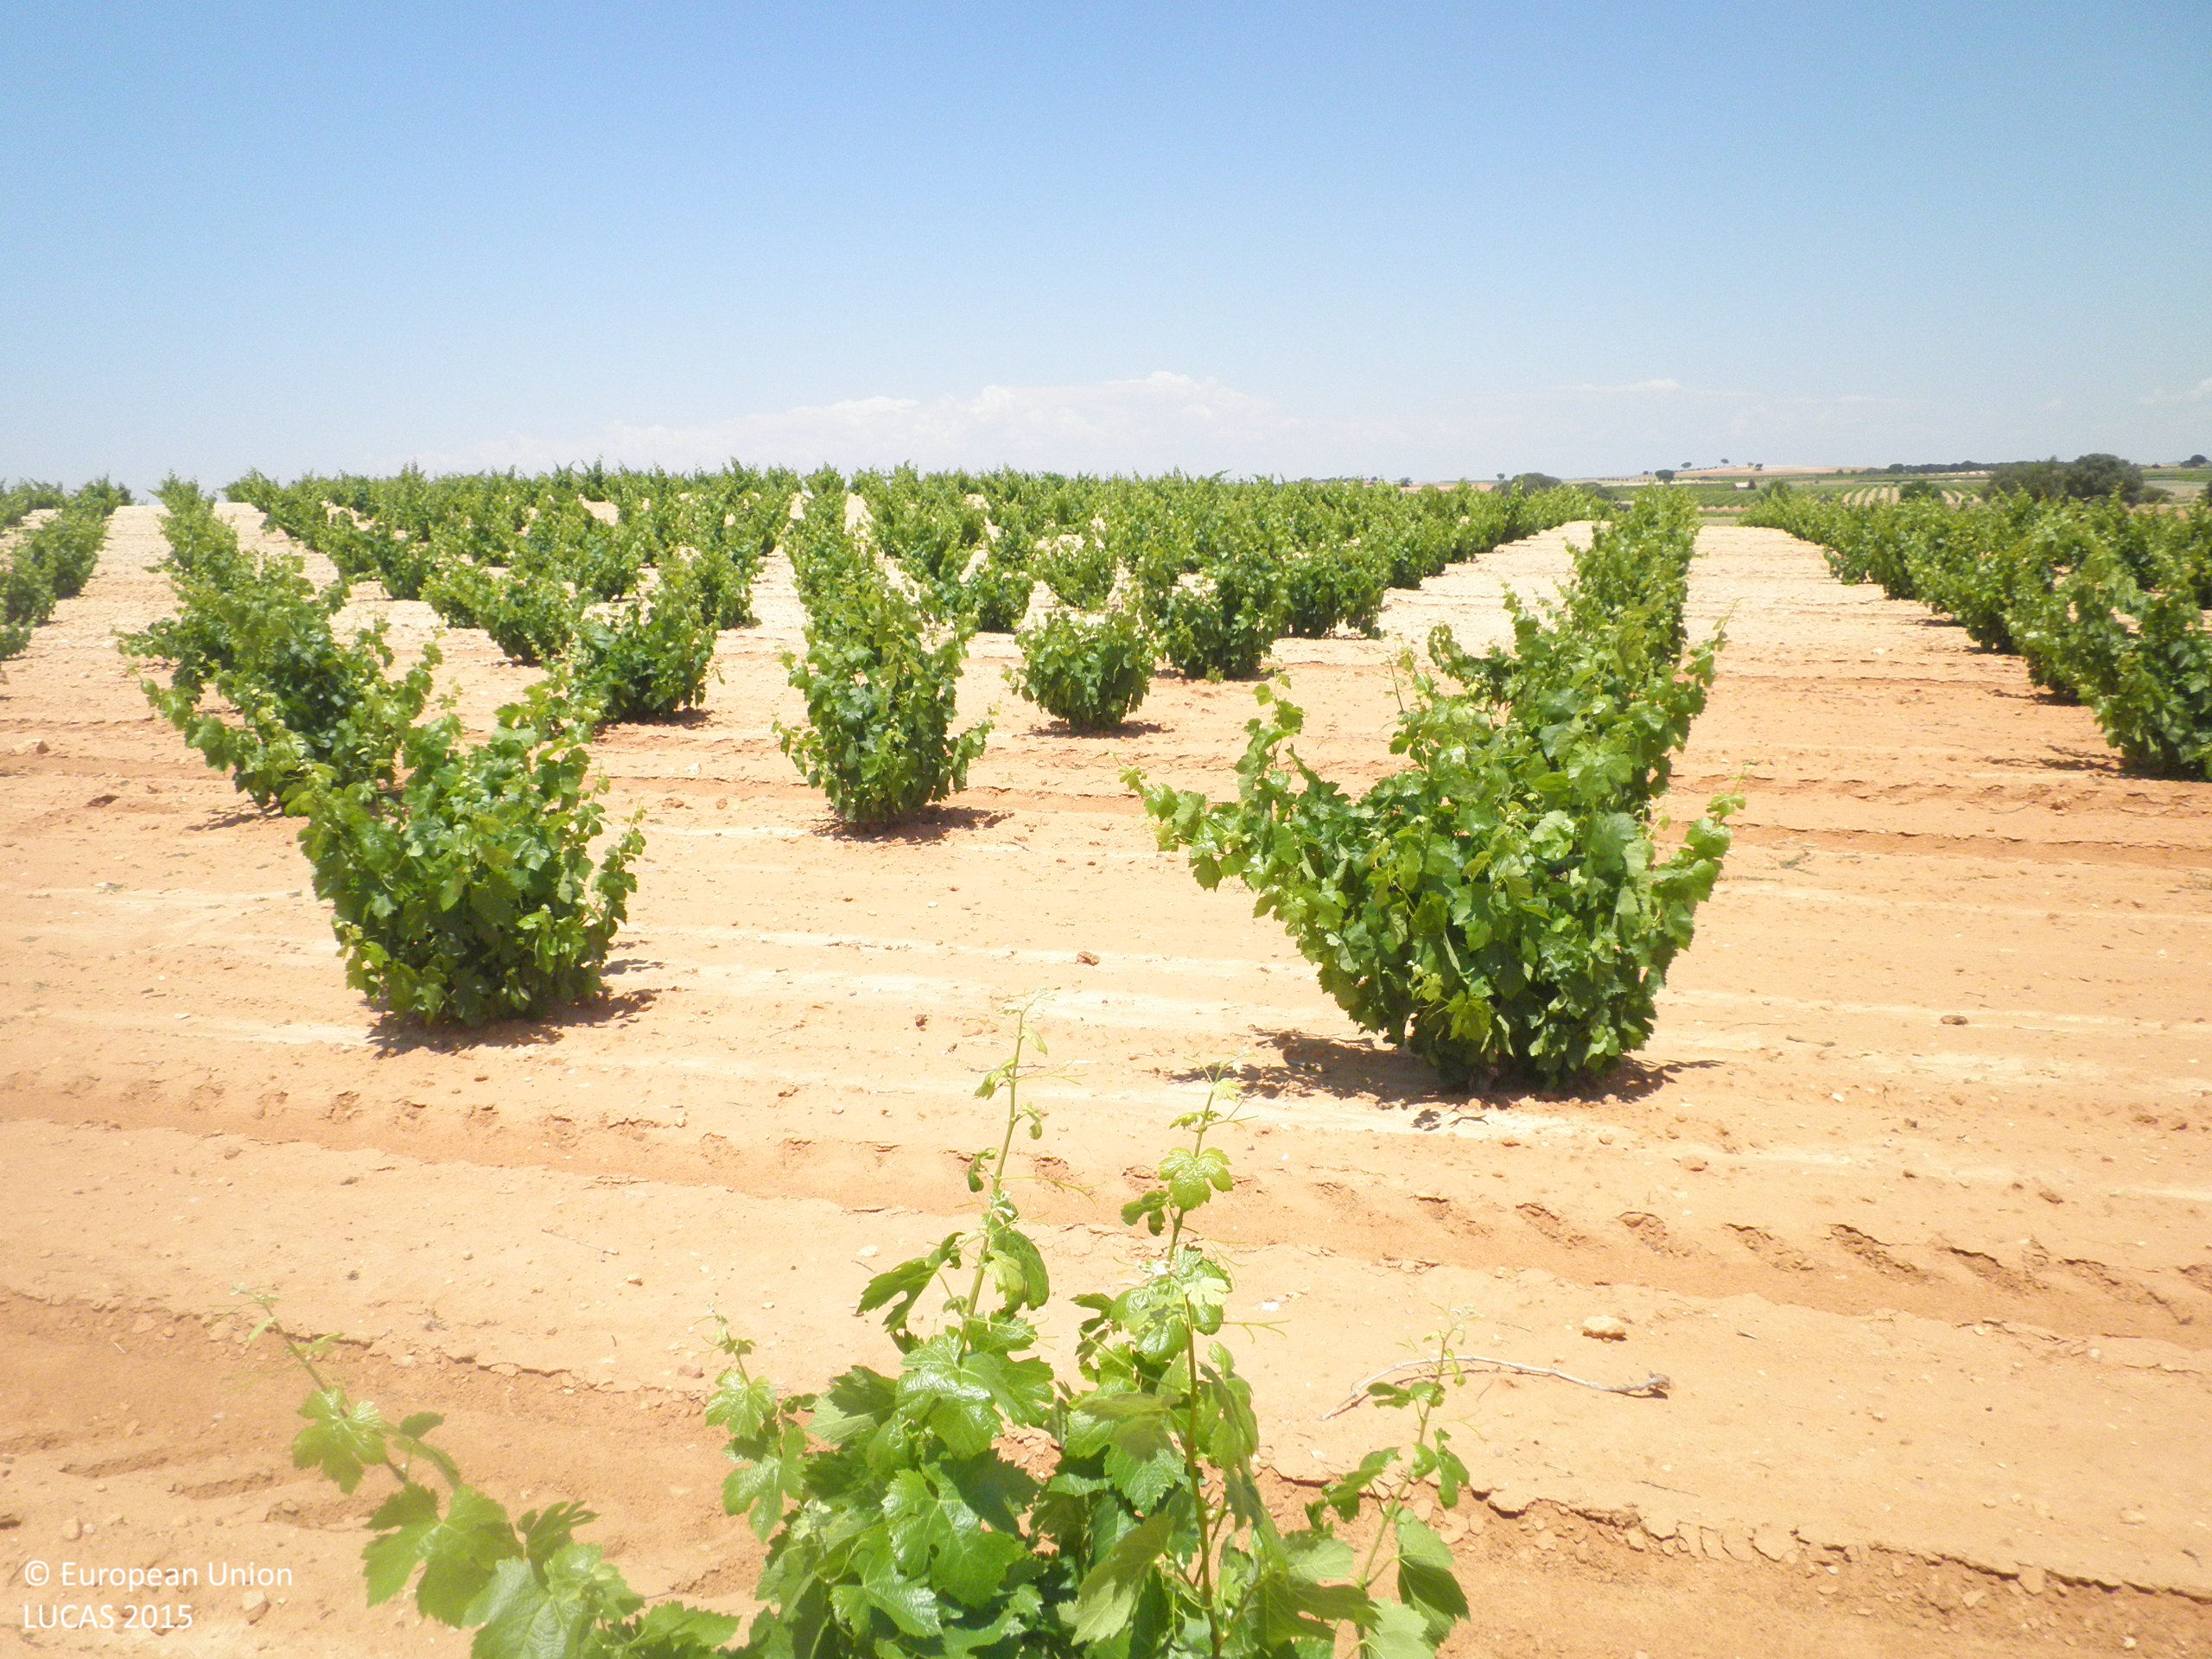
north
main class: Cropland
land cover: Vineyards
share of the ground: < 10 %
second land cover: Other bare soil
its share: > 75 %
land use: Agriculture (excluding fallow land and kitchen gardens)
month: June
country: ES
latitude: 39.2822
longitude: -1.7701
